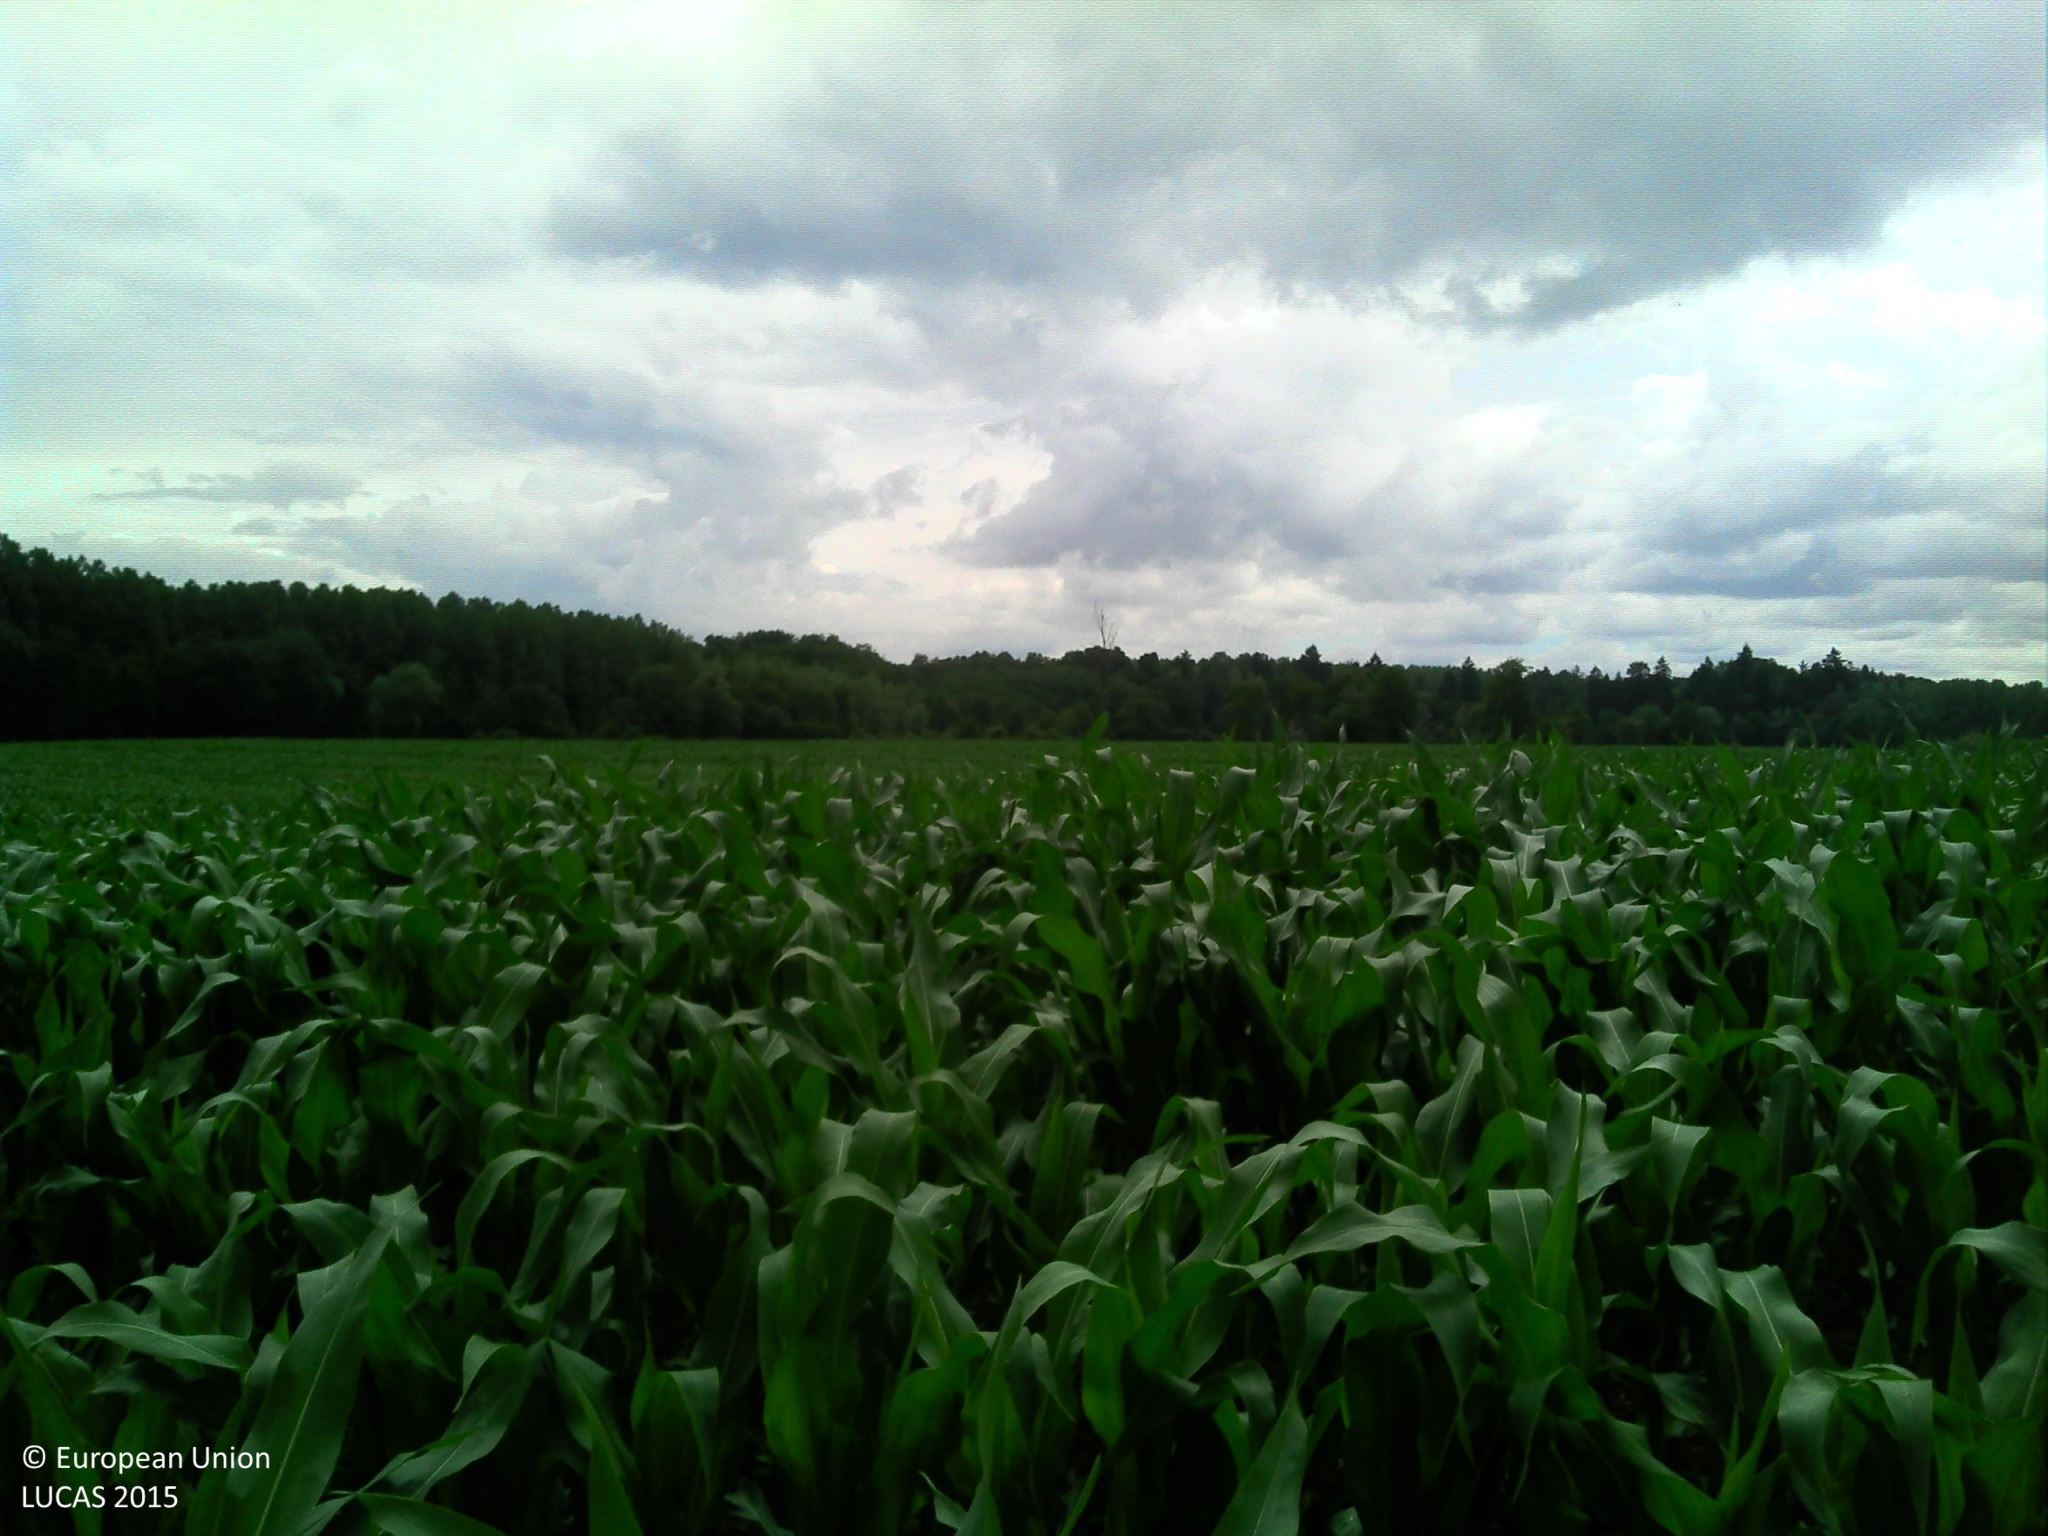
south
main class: Cropland
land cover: Rape and turnip rape
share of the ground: > 75 %
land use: Agriculture (excluding fallow land and kitchen gardens)
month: June
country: FR
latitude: 46.6610
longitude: 5.2581
